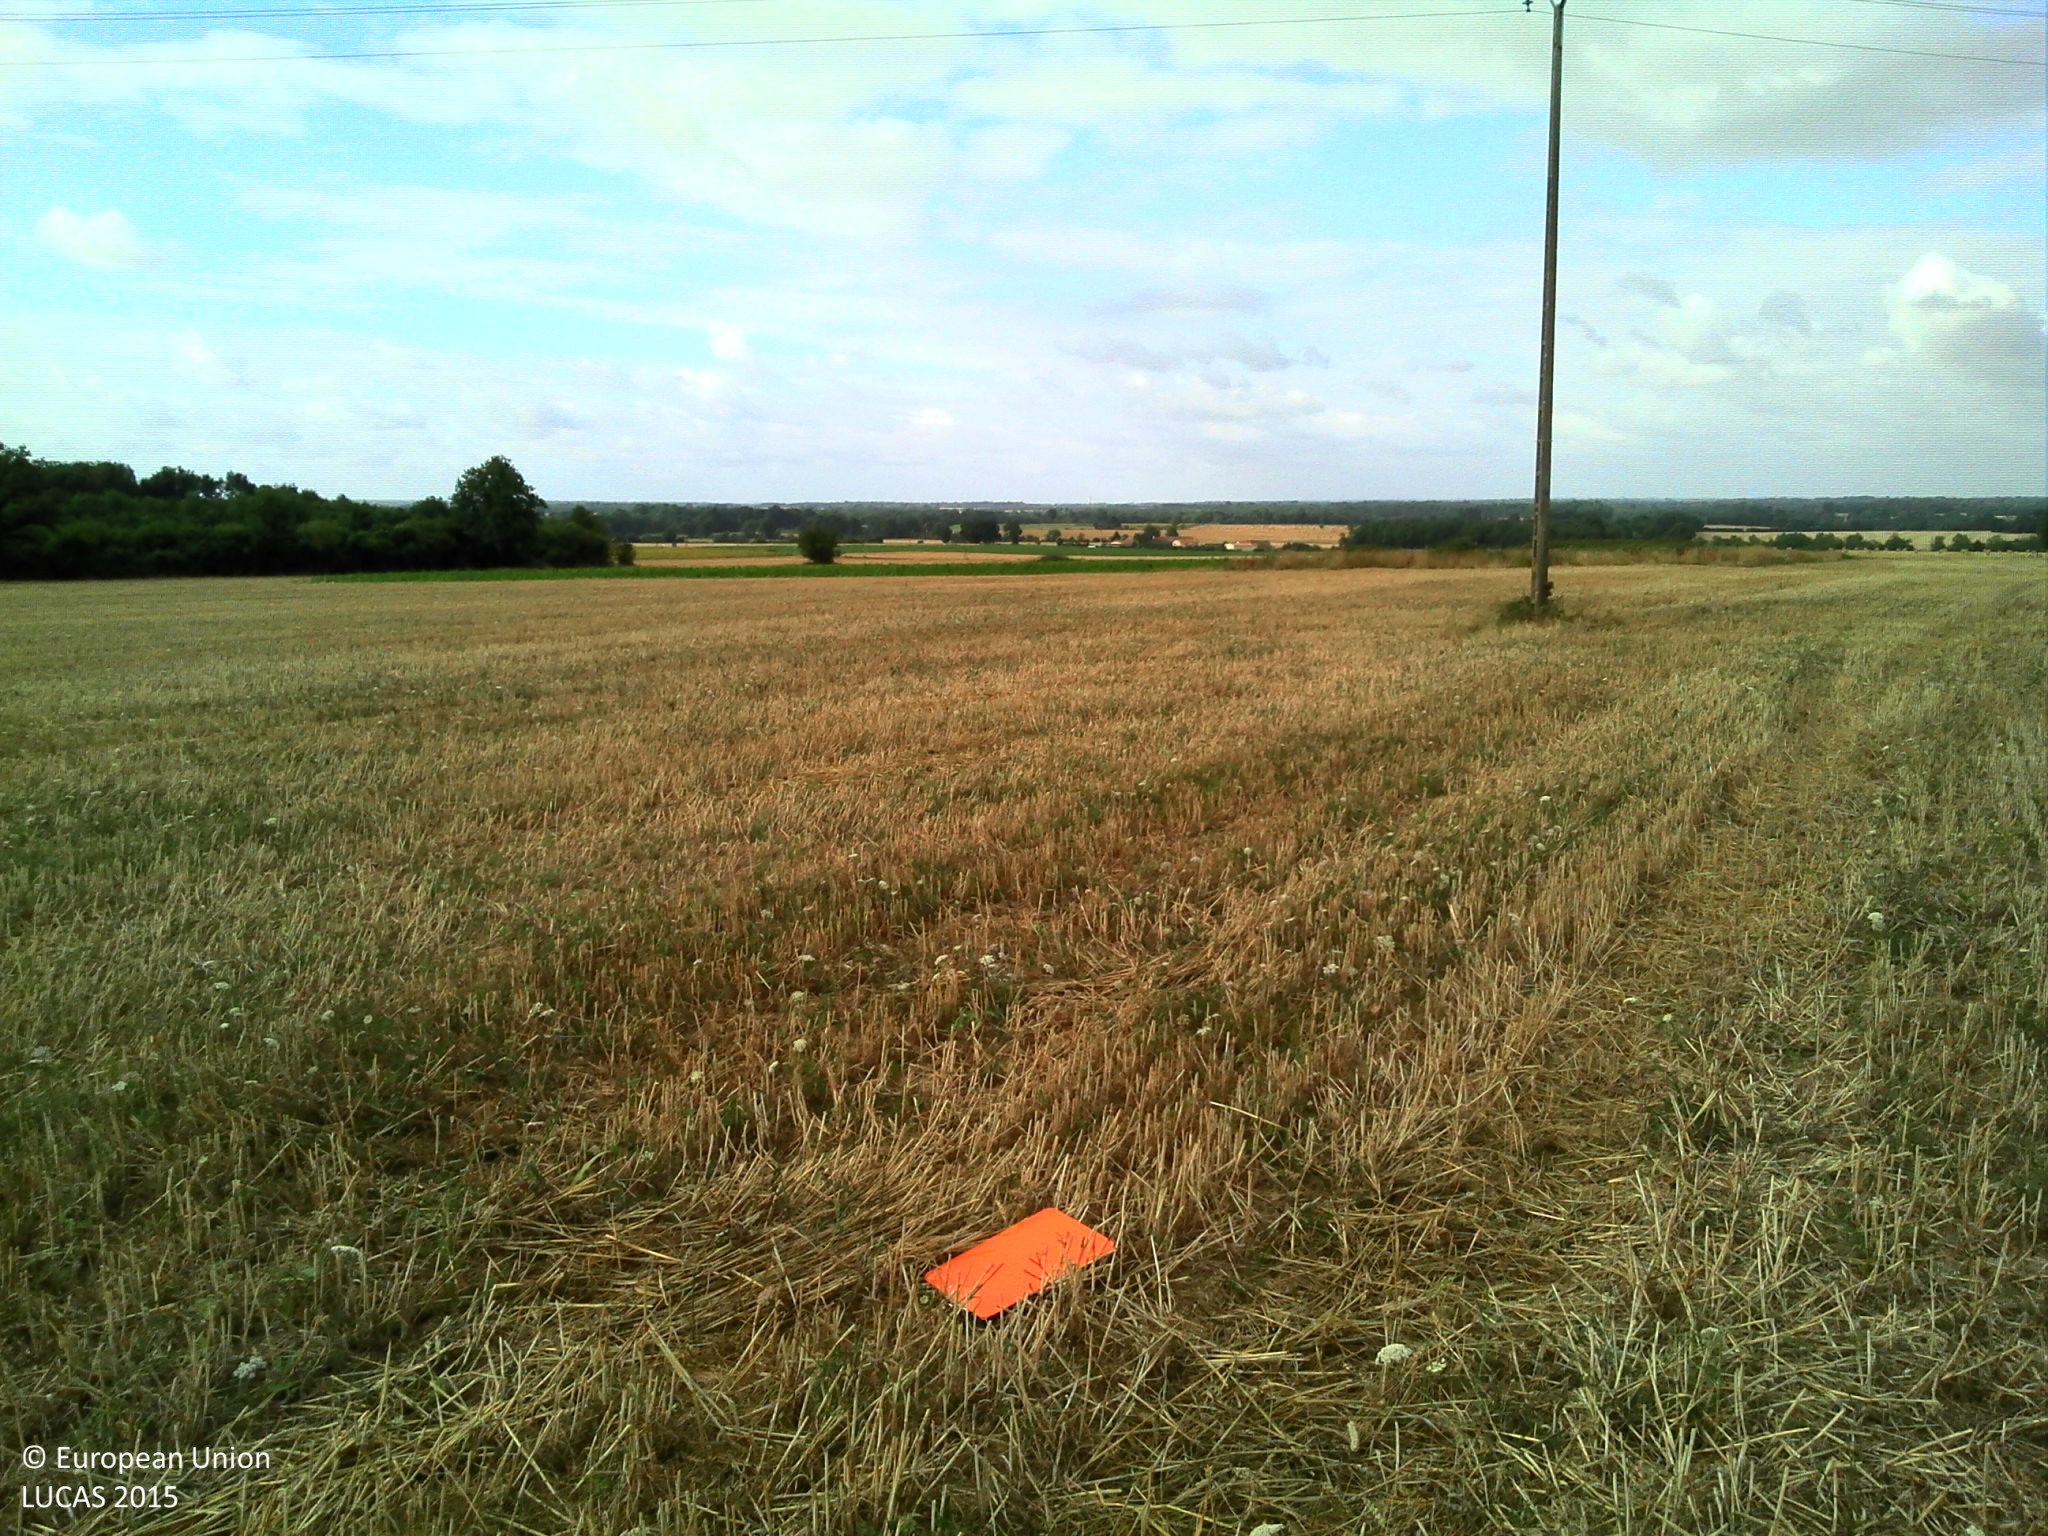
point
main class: Cropland
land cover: Common wheat
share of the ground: 50 - 75 %
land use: Agriculture (excluding fallow land and kitchen gardens)
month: July
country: FR
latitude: 46.3114
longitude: 0.3338
